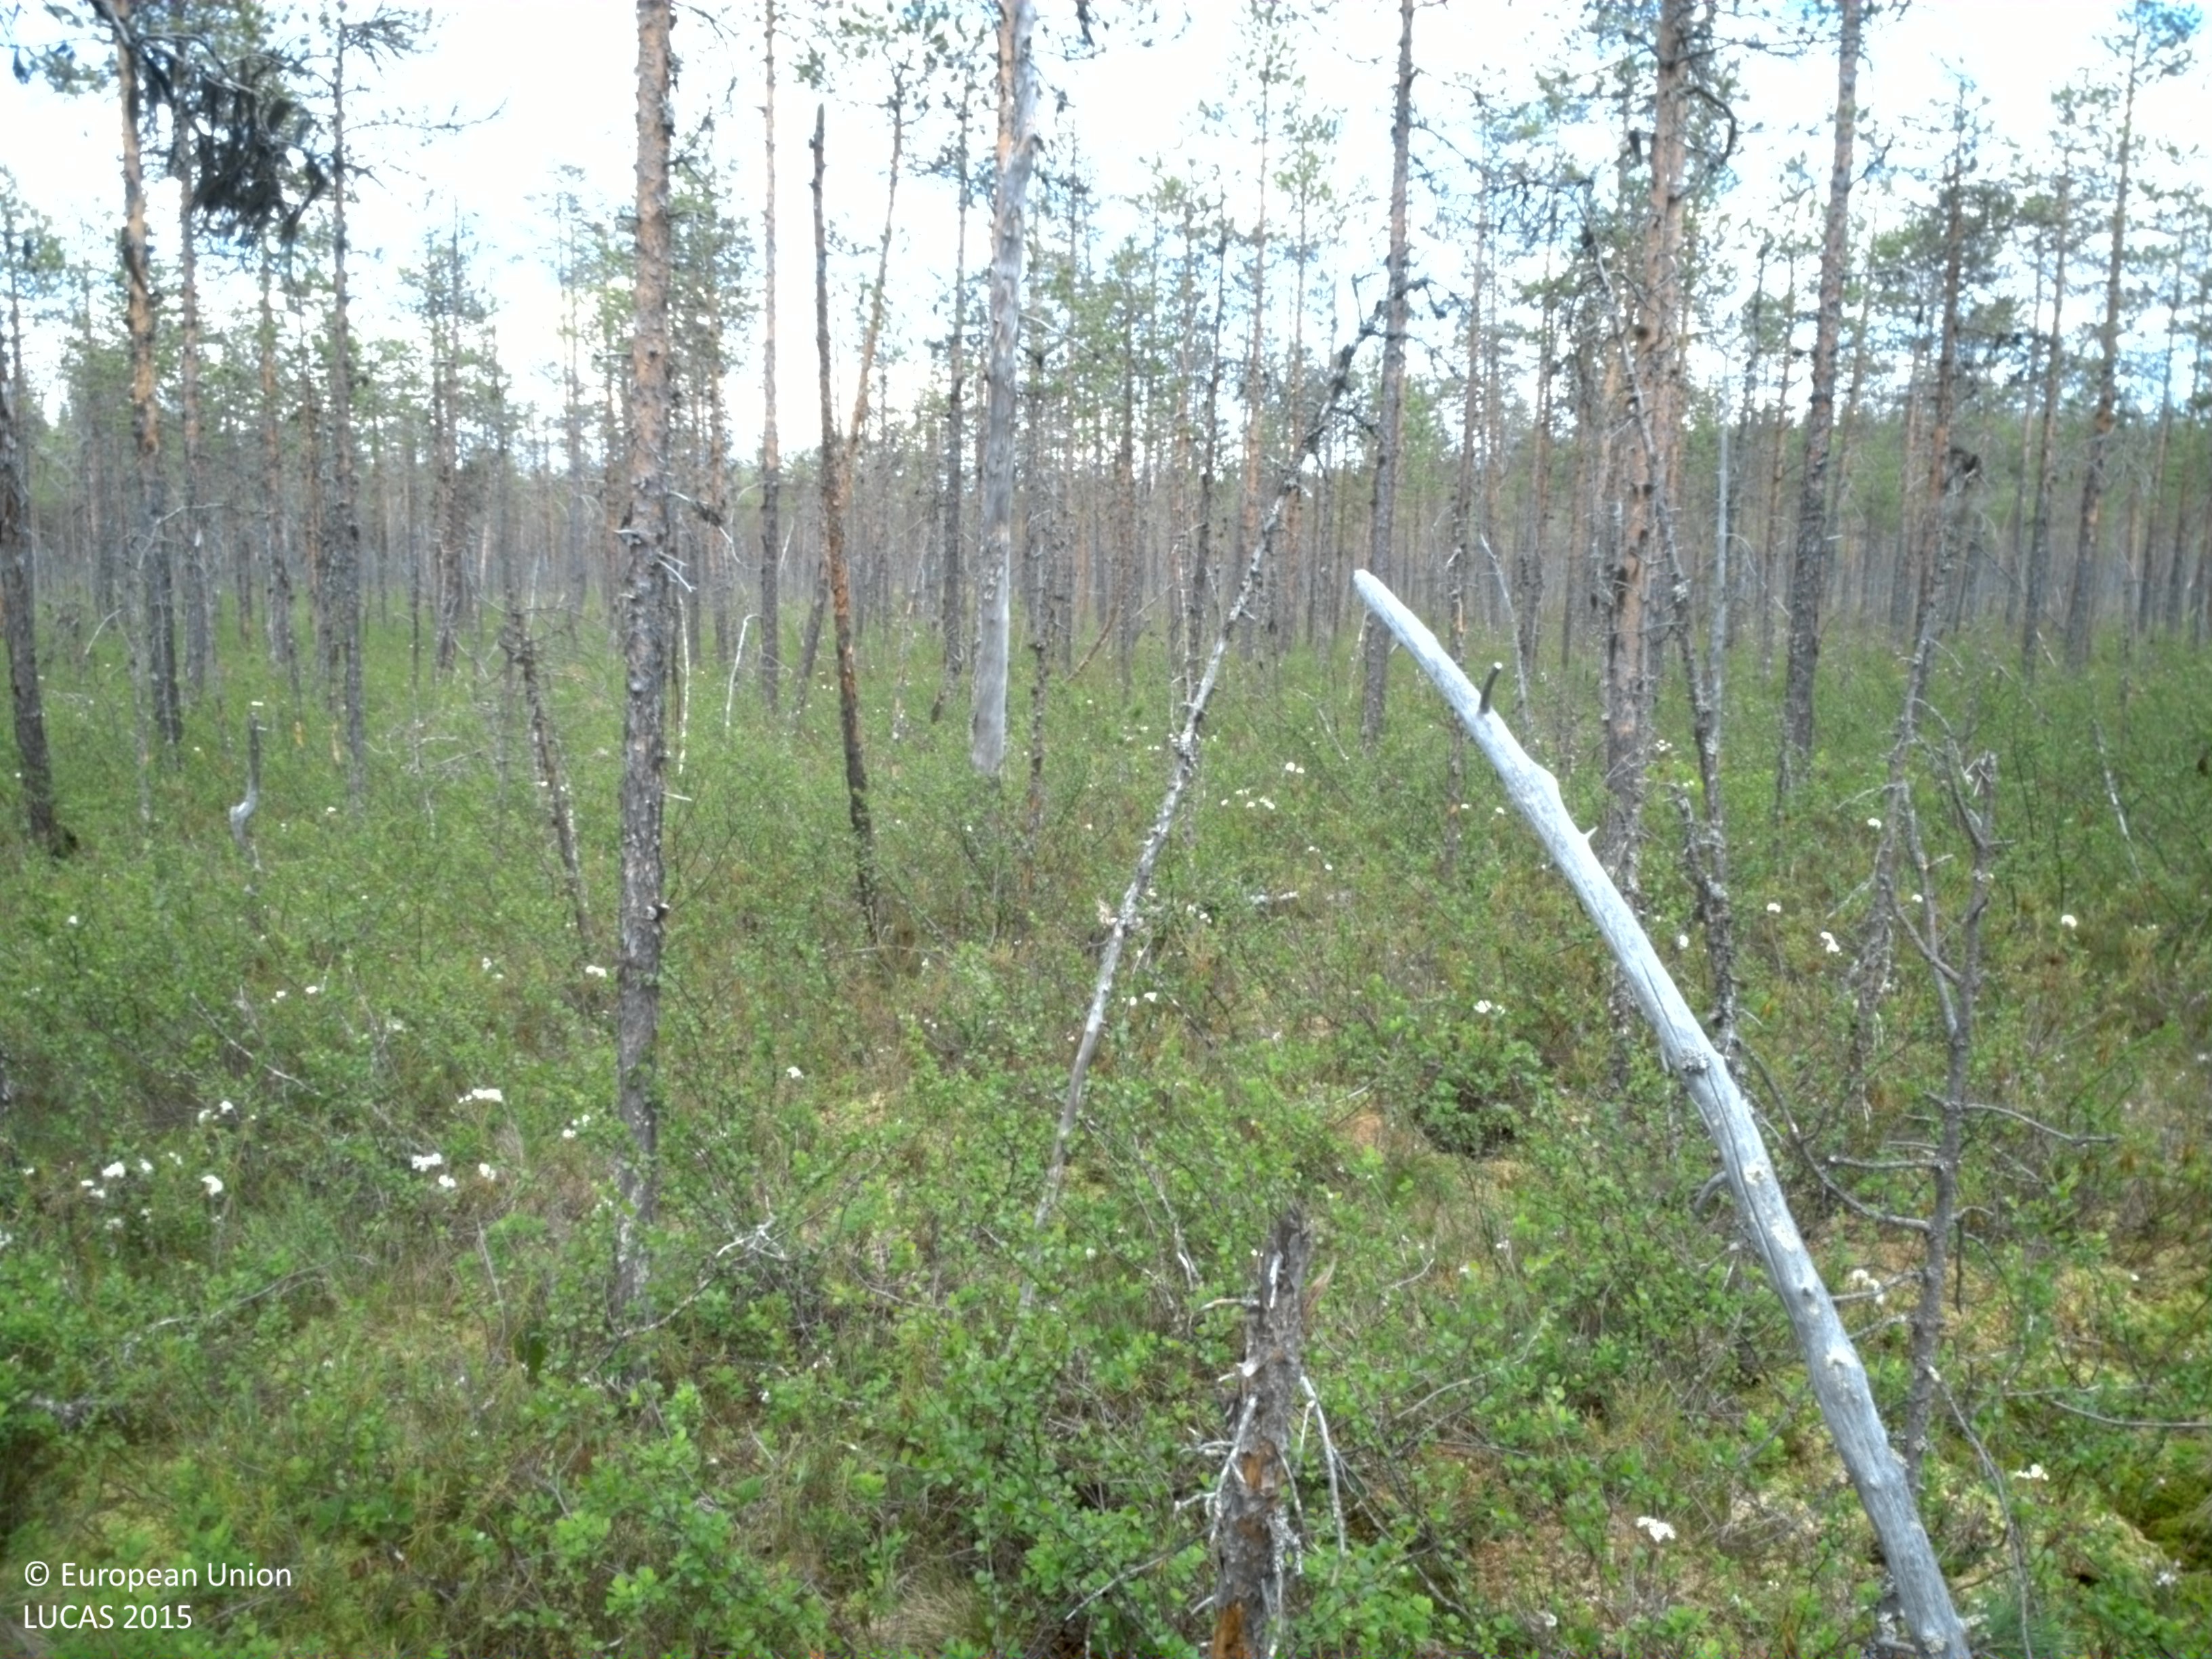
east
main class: Woodland
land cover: Pine dominated coniferous woodland
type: mire and swamp forests
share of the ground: 25 - 50 %
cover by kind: shrubs 65 %, coniferous forest trees 30 %, lichens and mosses 5 %
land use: Semi-natural and natural areas not in use
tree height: > 5 m
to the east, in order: Pine dominated coniferous woodland; Broadleaved woodland
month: June
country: SE
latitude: 66.4377
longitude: 22.4589
